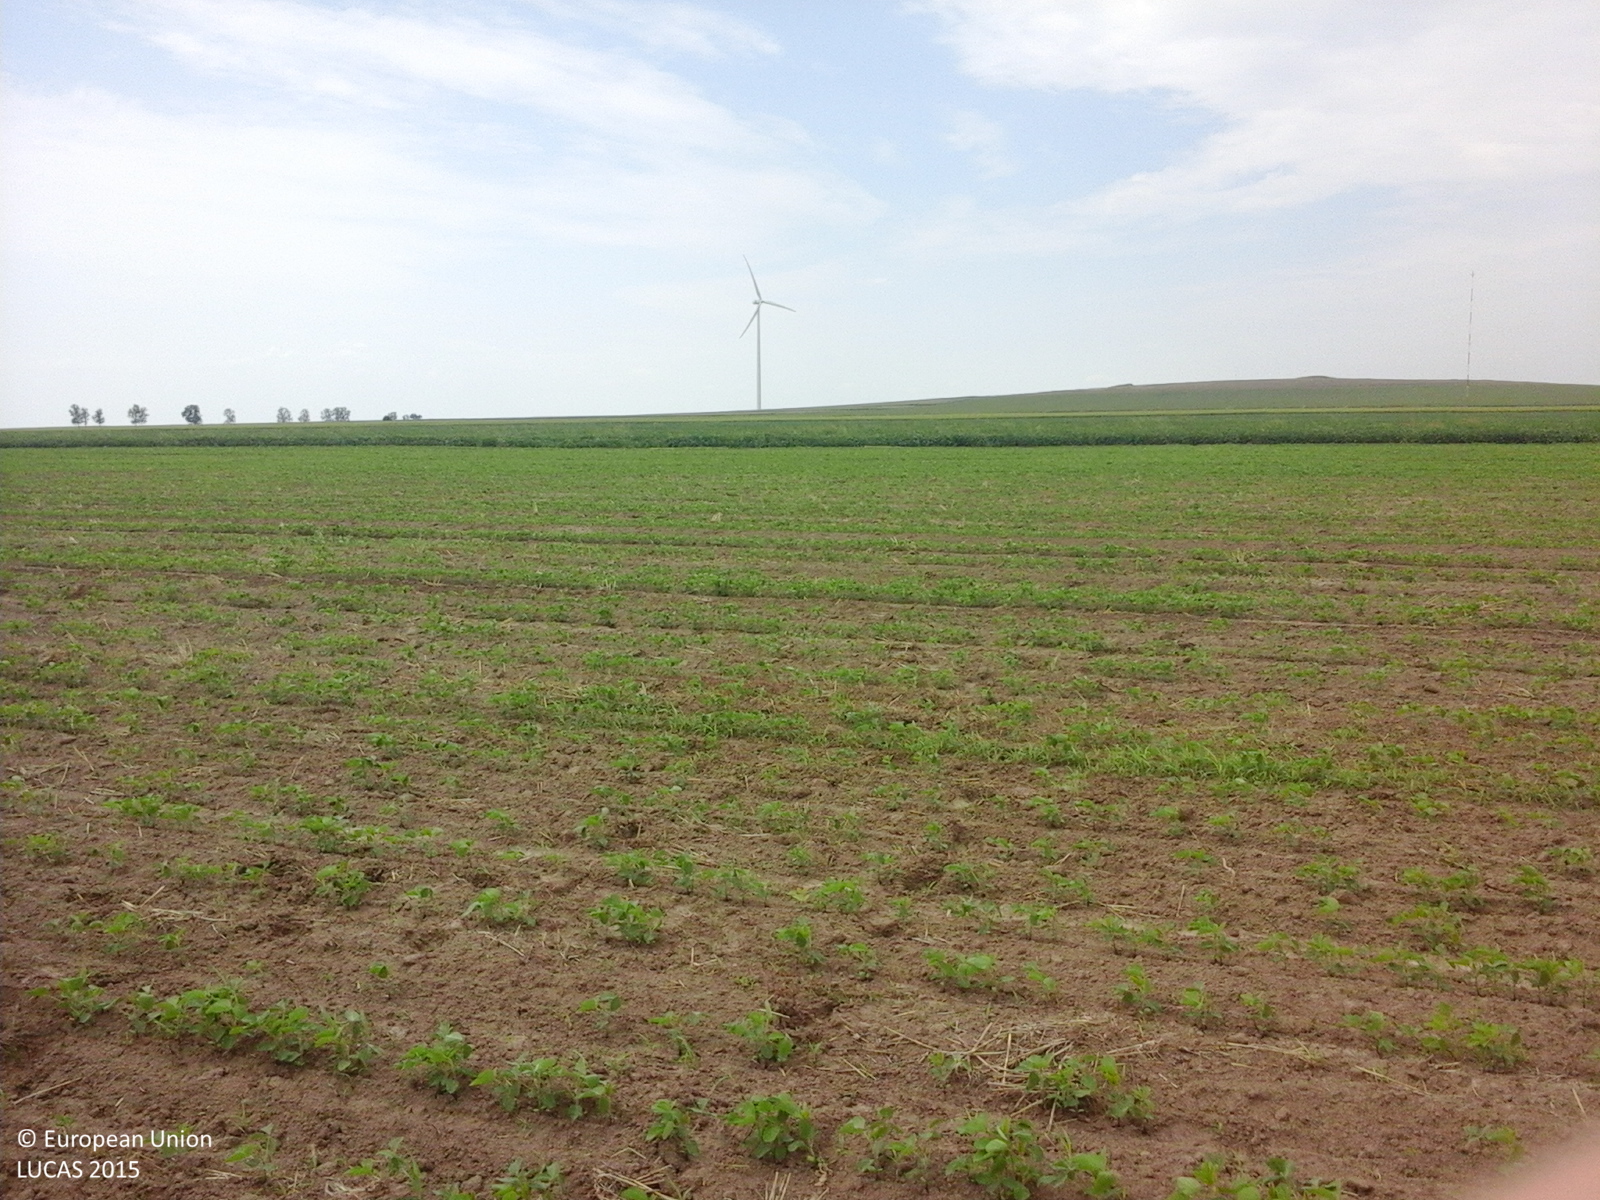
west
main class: Cropland
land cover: Soya
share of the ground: 10 - 25 %
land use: Agriculture (excluding fallow land and kitchen gardens)
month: August
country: RO
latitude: 45.0349
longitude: 28.9961
